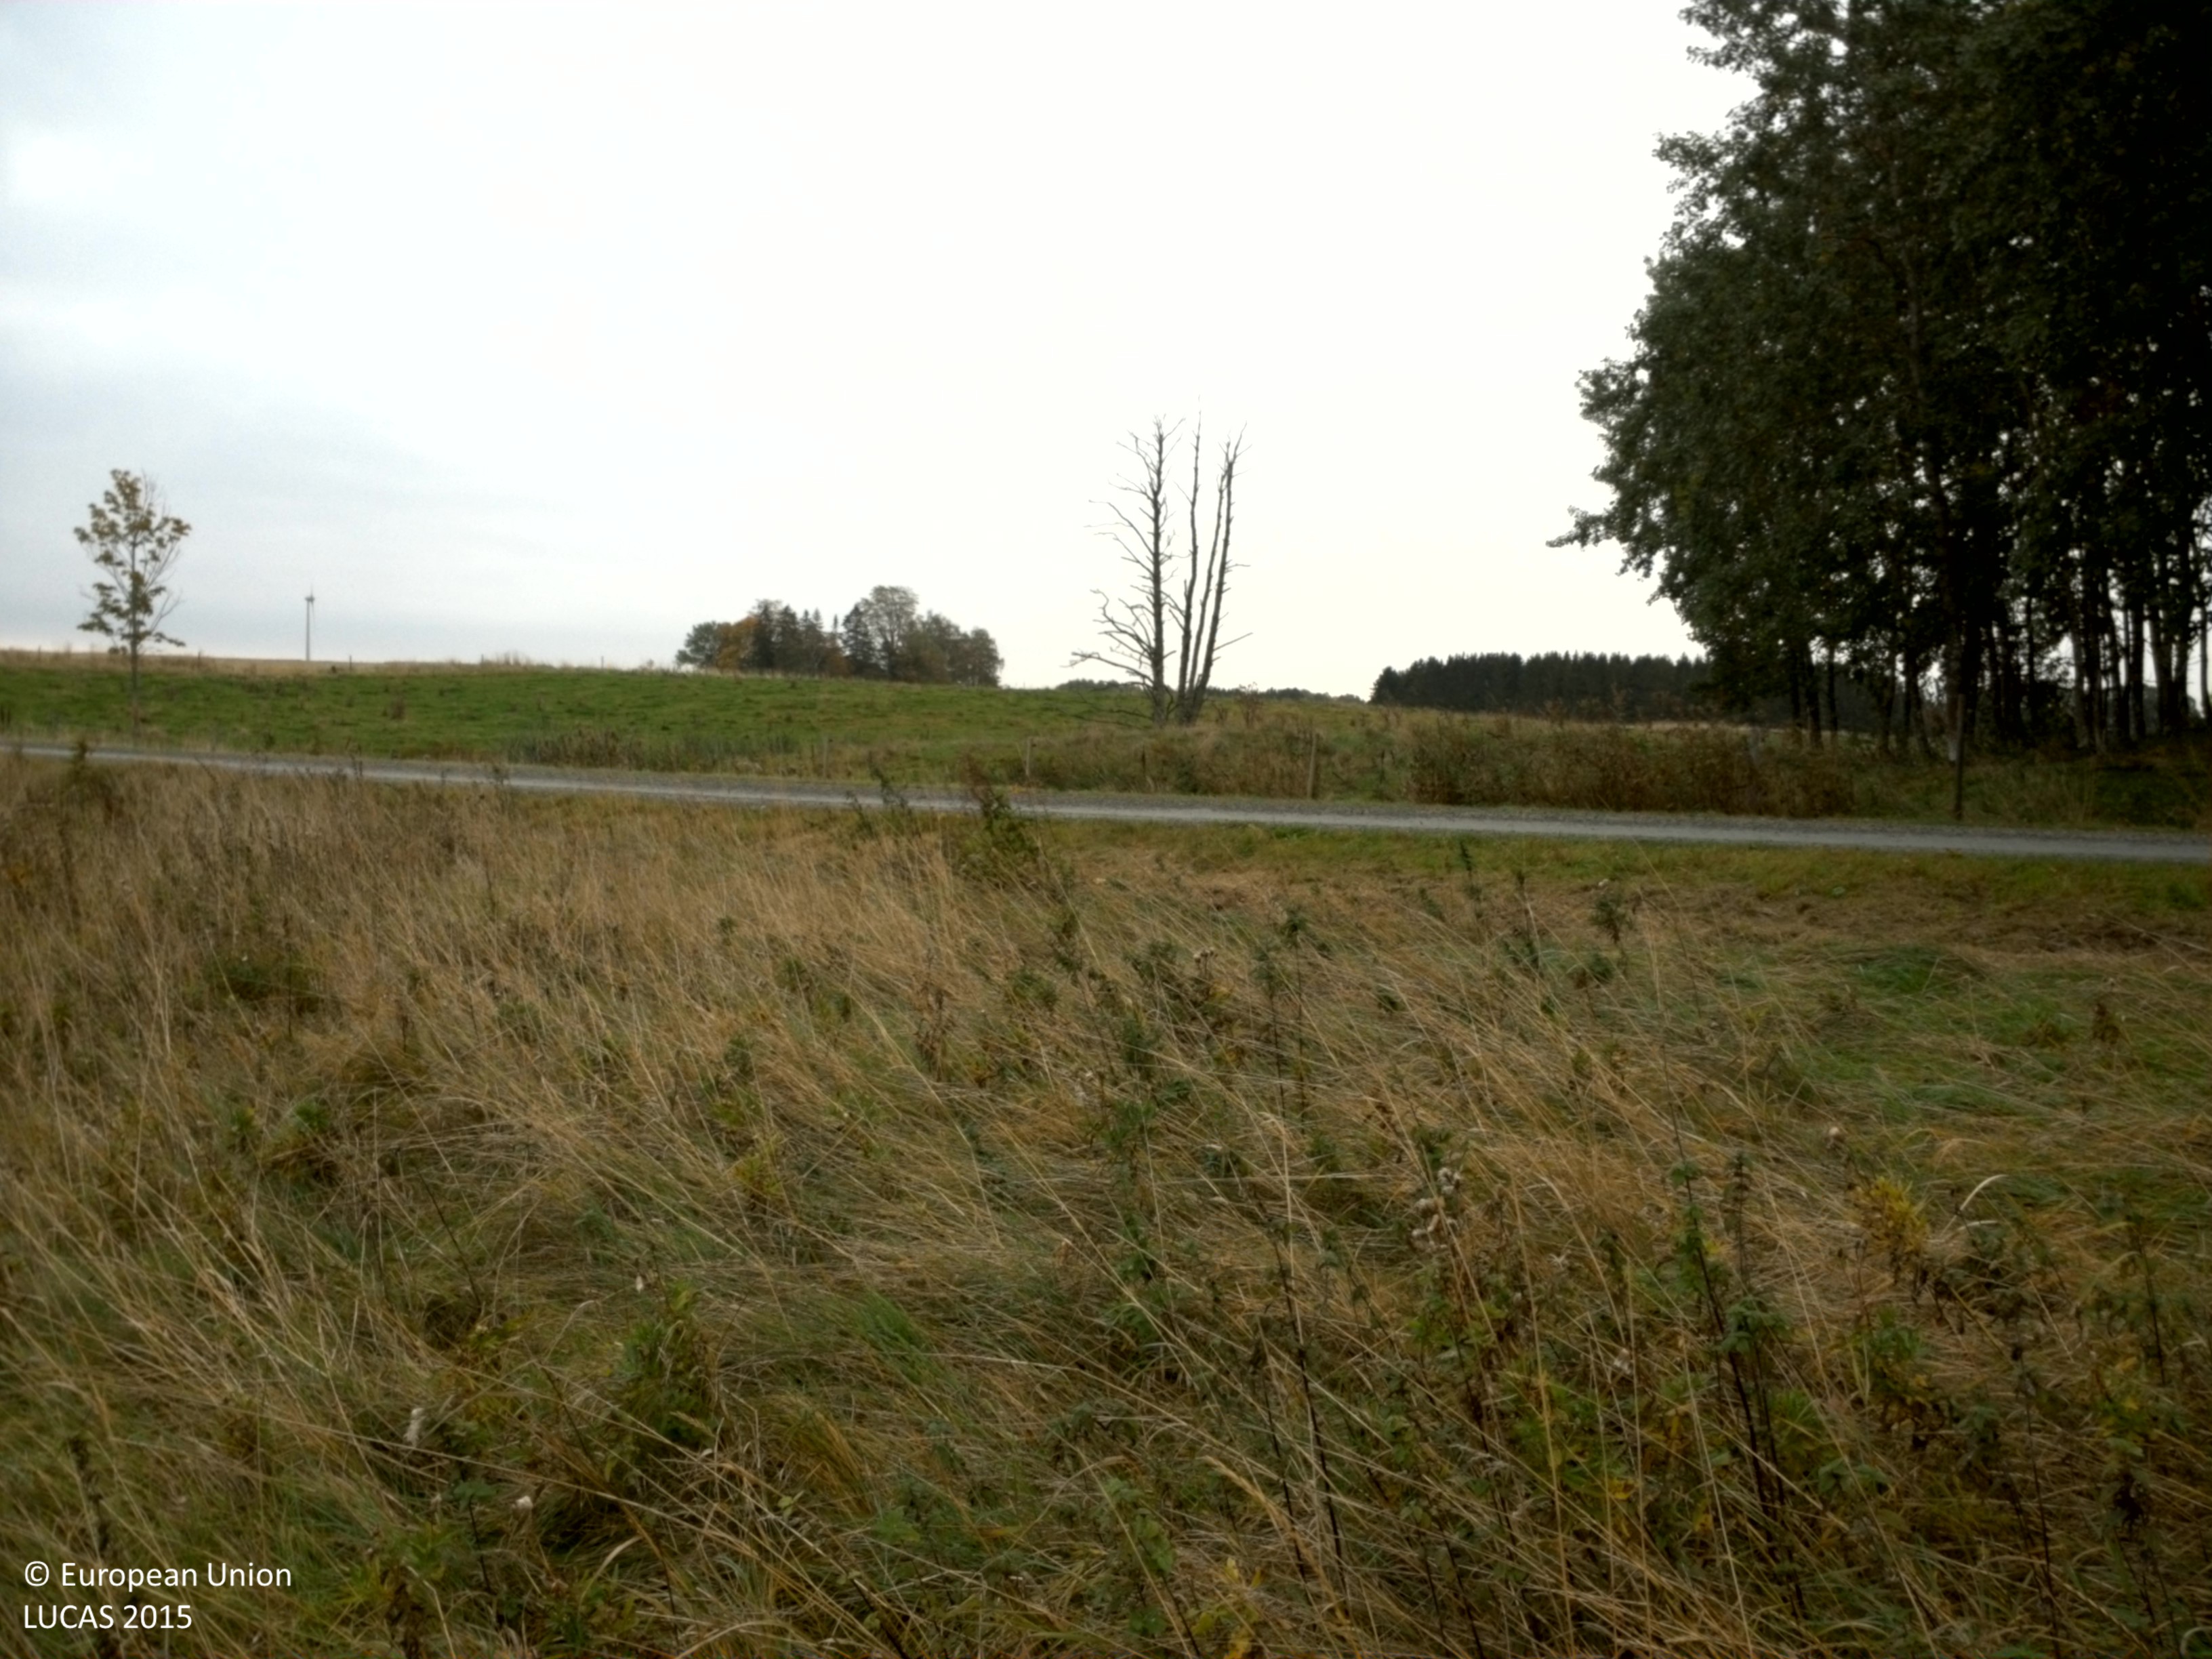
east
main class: Grassland
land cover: Grassland without tree/shrub cover
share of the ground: > 75 %
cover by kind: herbaceous plants 100 %
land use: Semi-natural and natural areas not in use
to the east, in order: Grassland without tree/shrub cover; Paved roads, cycling and walking lanes; Grass margins; Ditches and canals; Fences; Grassland with sparse tree/shrub cover; Inland marshes; Grassland without tree/shrub cover; Fences; Grass margins; Common wheat
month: October
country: SE
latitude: 58.3132
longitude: 12.9476
